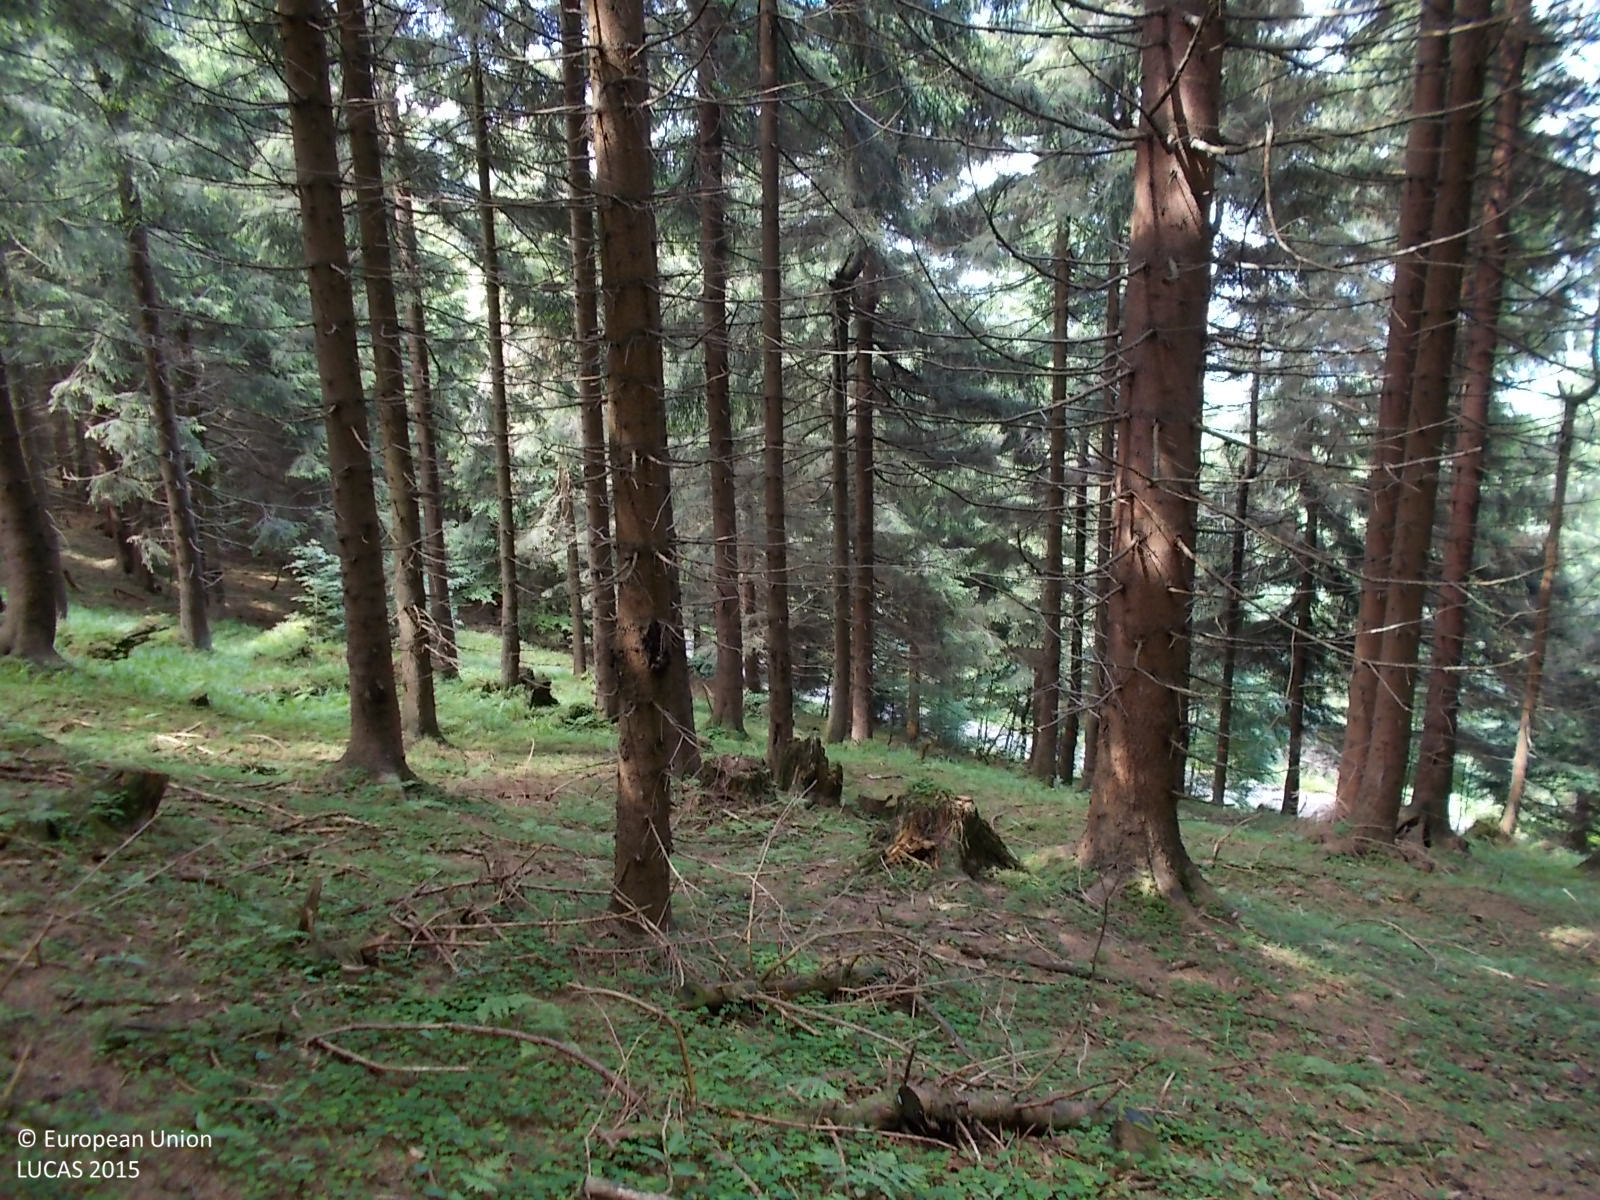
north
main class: Woodland
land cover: Spruce dominated coniferous woodland
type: alpine coniferous forest
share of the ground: > 75 %
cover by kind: coniferous forest trees 80 %, herbaceous plants 10 %, lichens and mosses 5 %, unconsolidated bare surface 5 %
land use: Forestry
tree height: > 5 m
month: June
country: CZ
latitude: 50.1199
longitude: 17.1856
